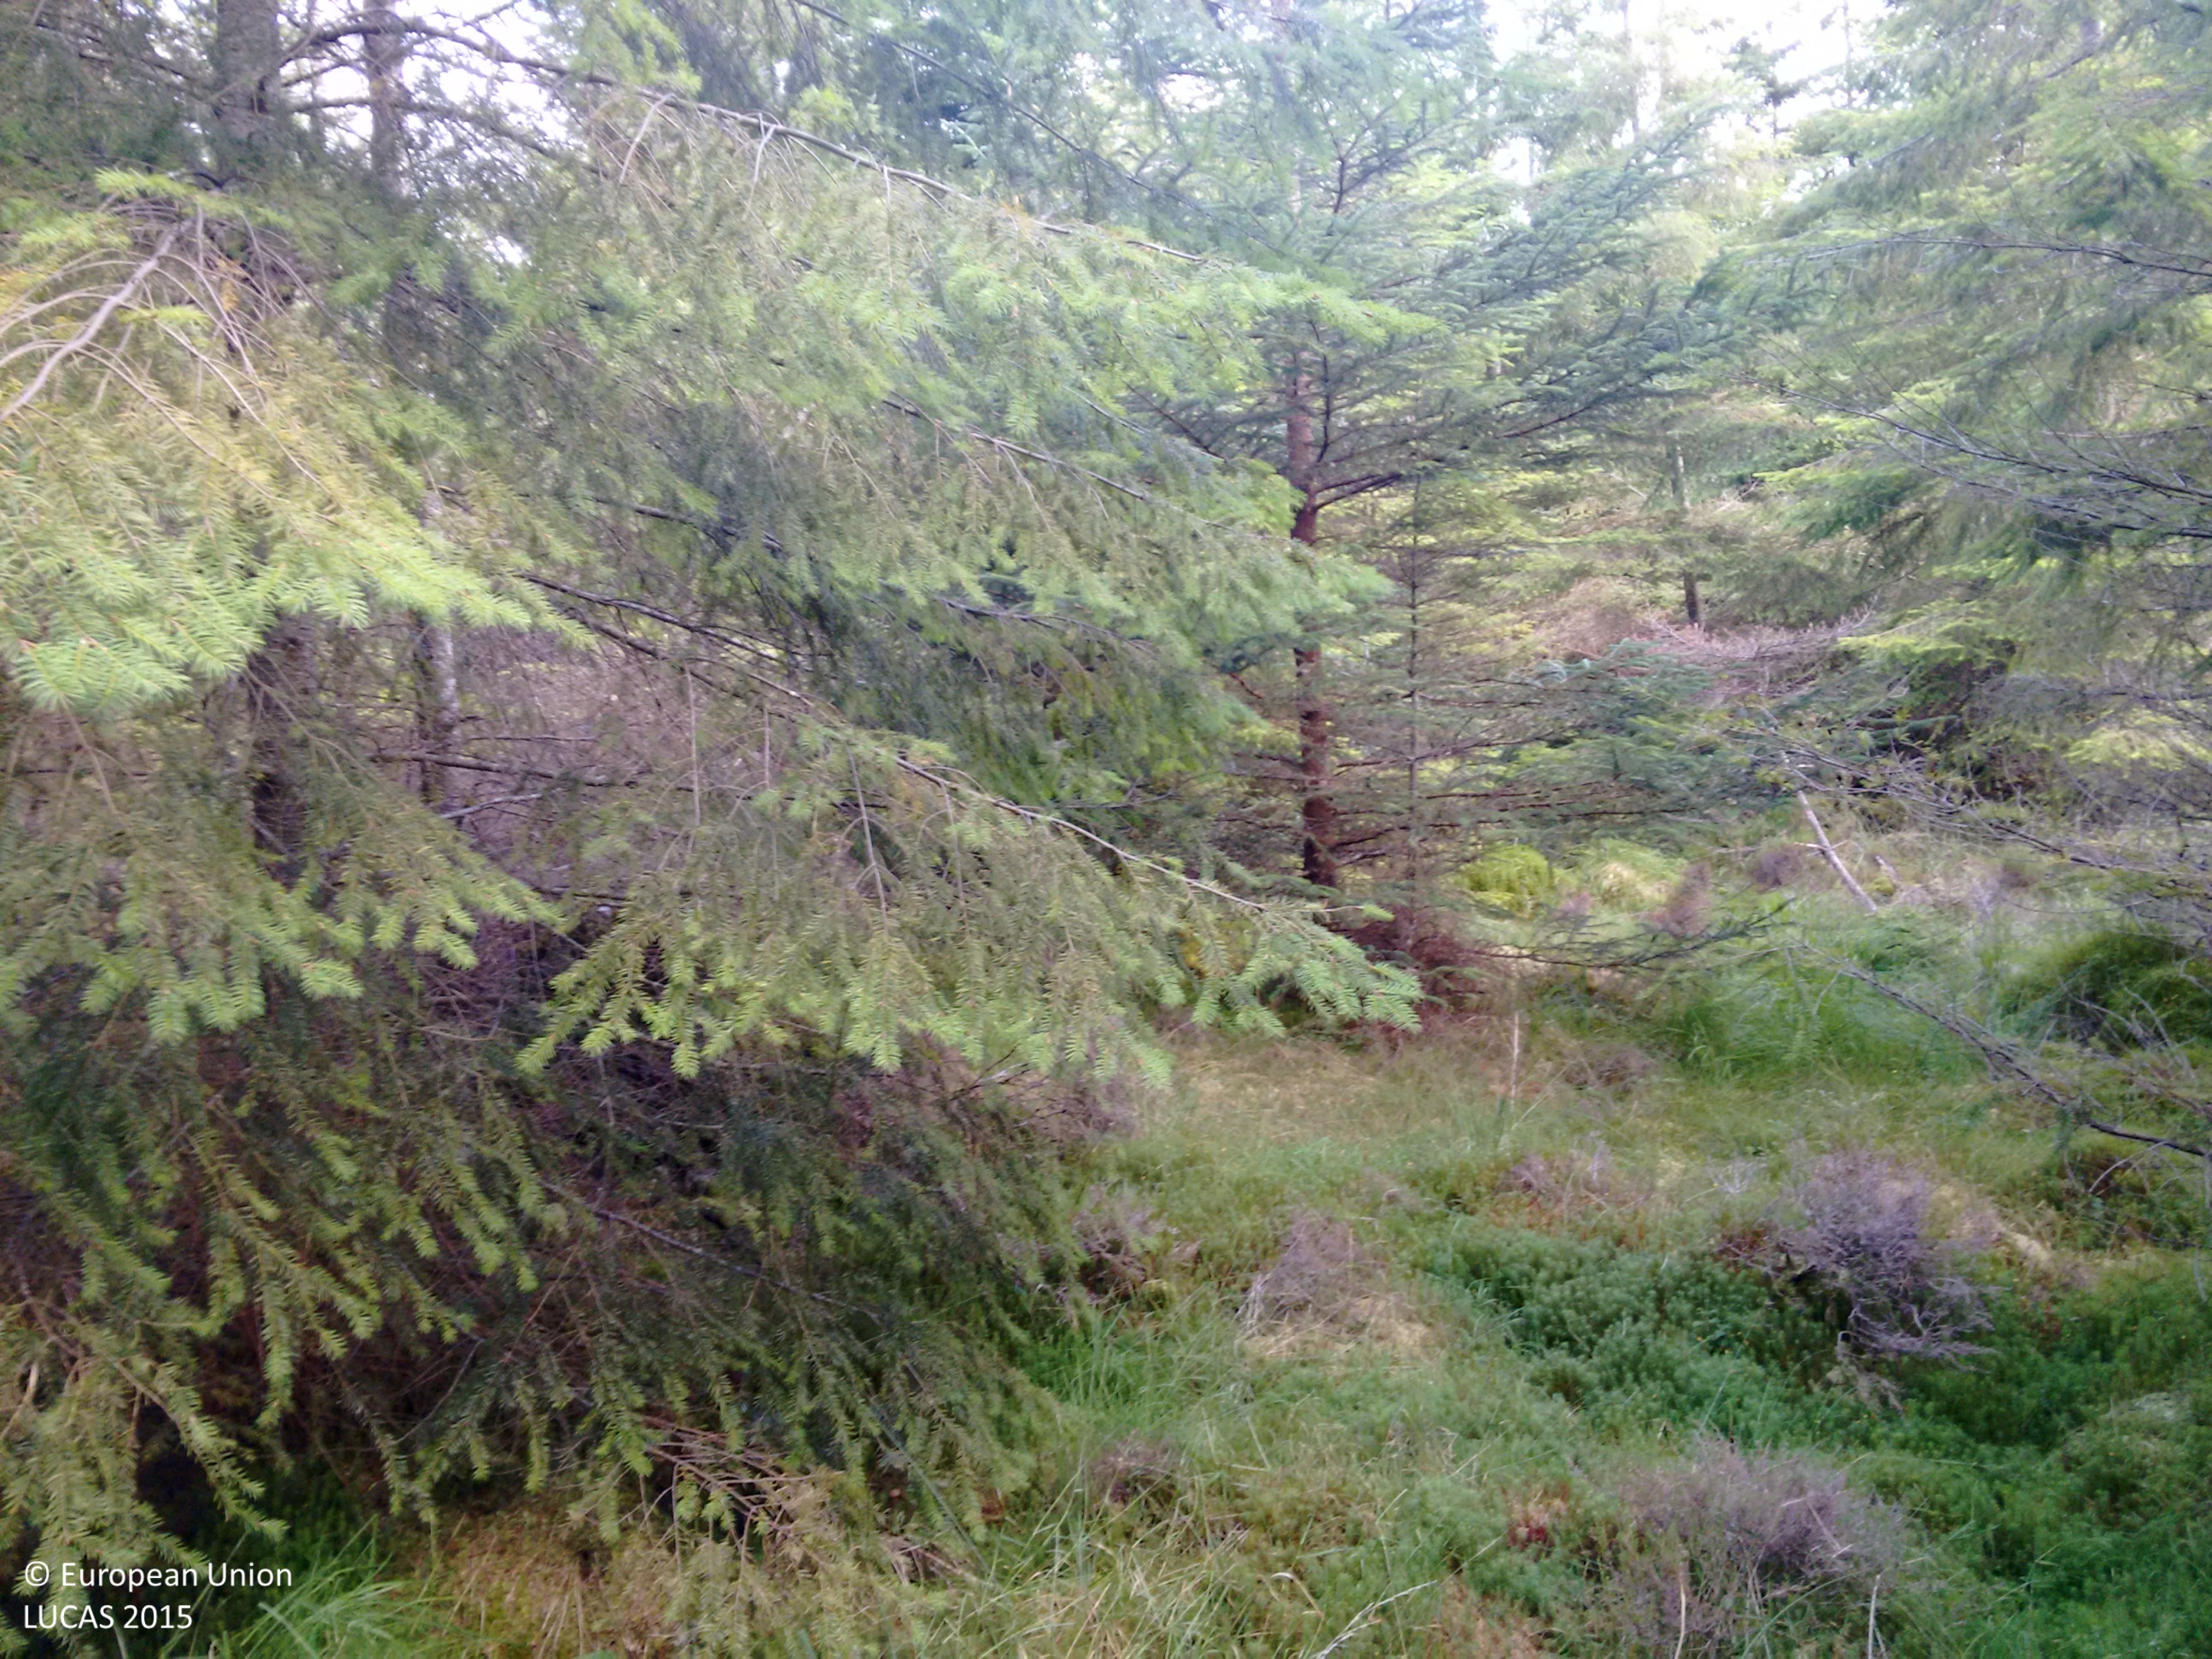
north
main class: Woodland
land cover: Spruce dominated coniferous woodland
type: exotic forest
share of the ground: > 75 %
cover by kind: coniferous forest trees 100 %
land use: Forestry
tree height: > 5 m
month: September
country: GB
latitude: 57.6445
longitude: -4.6868
